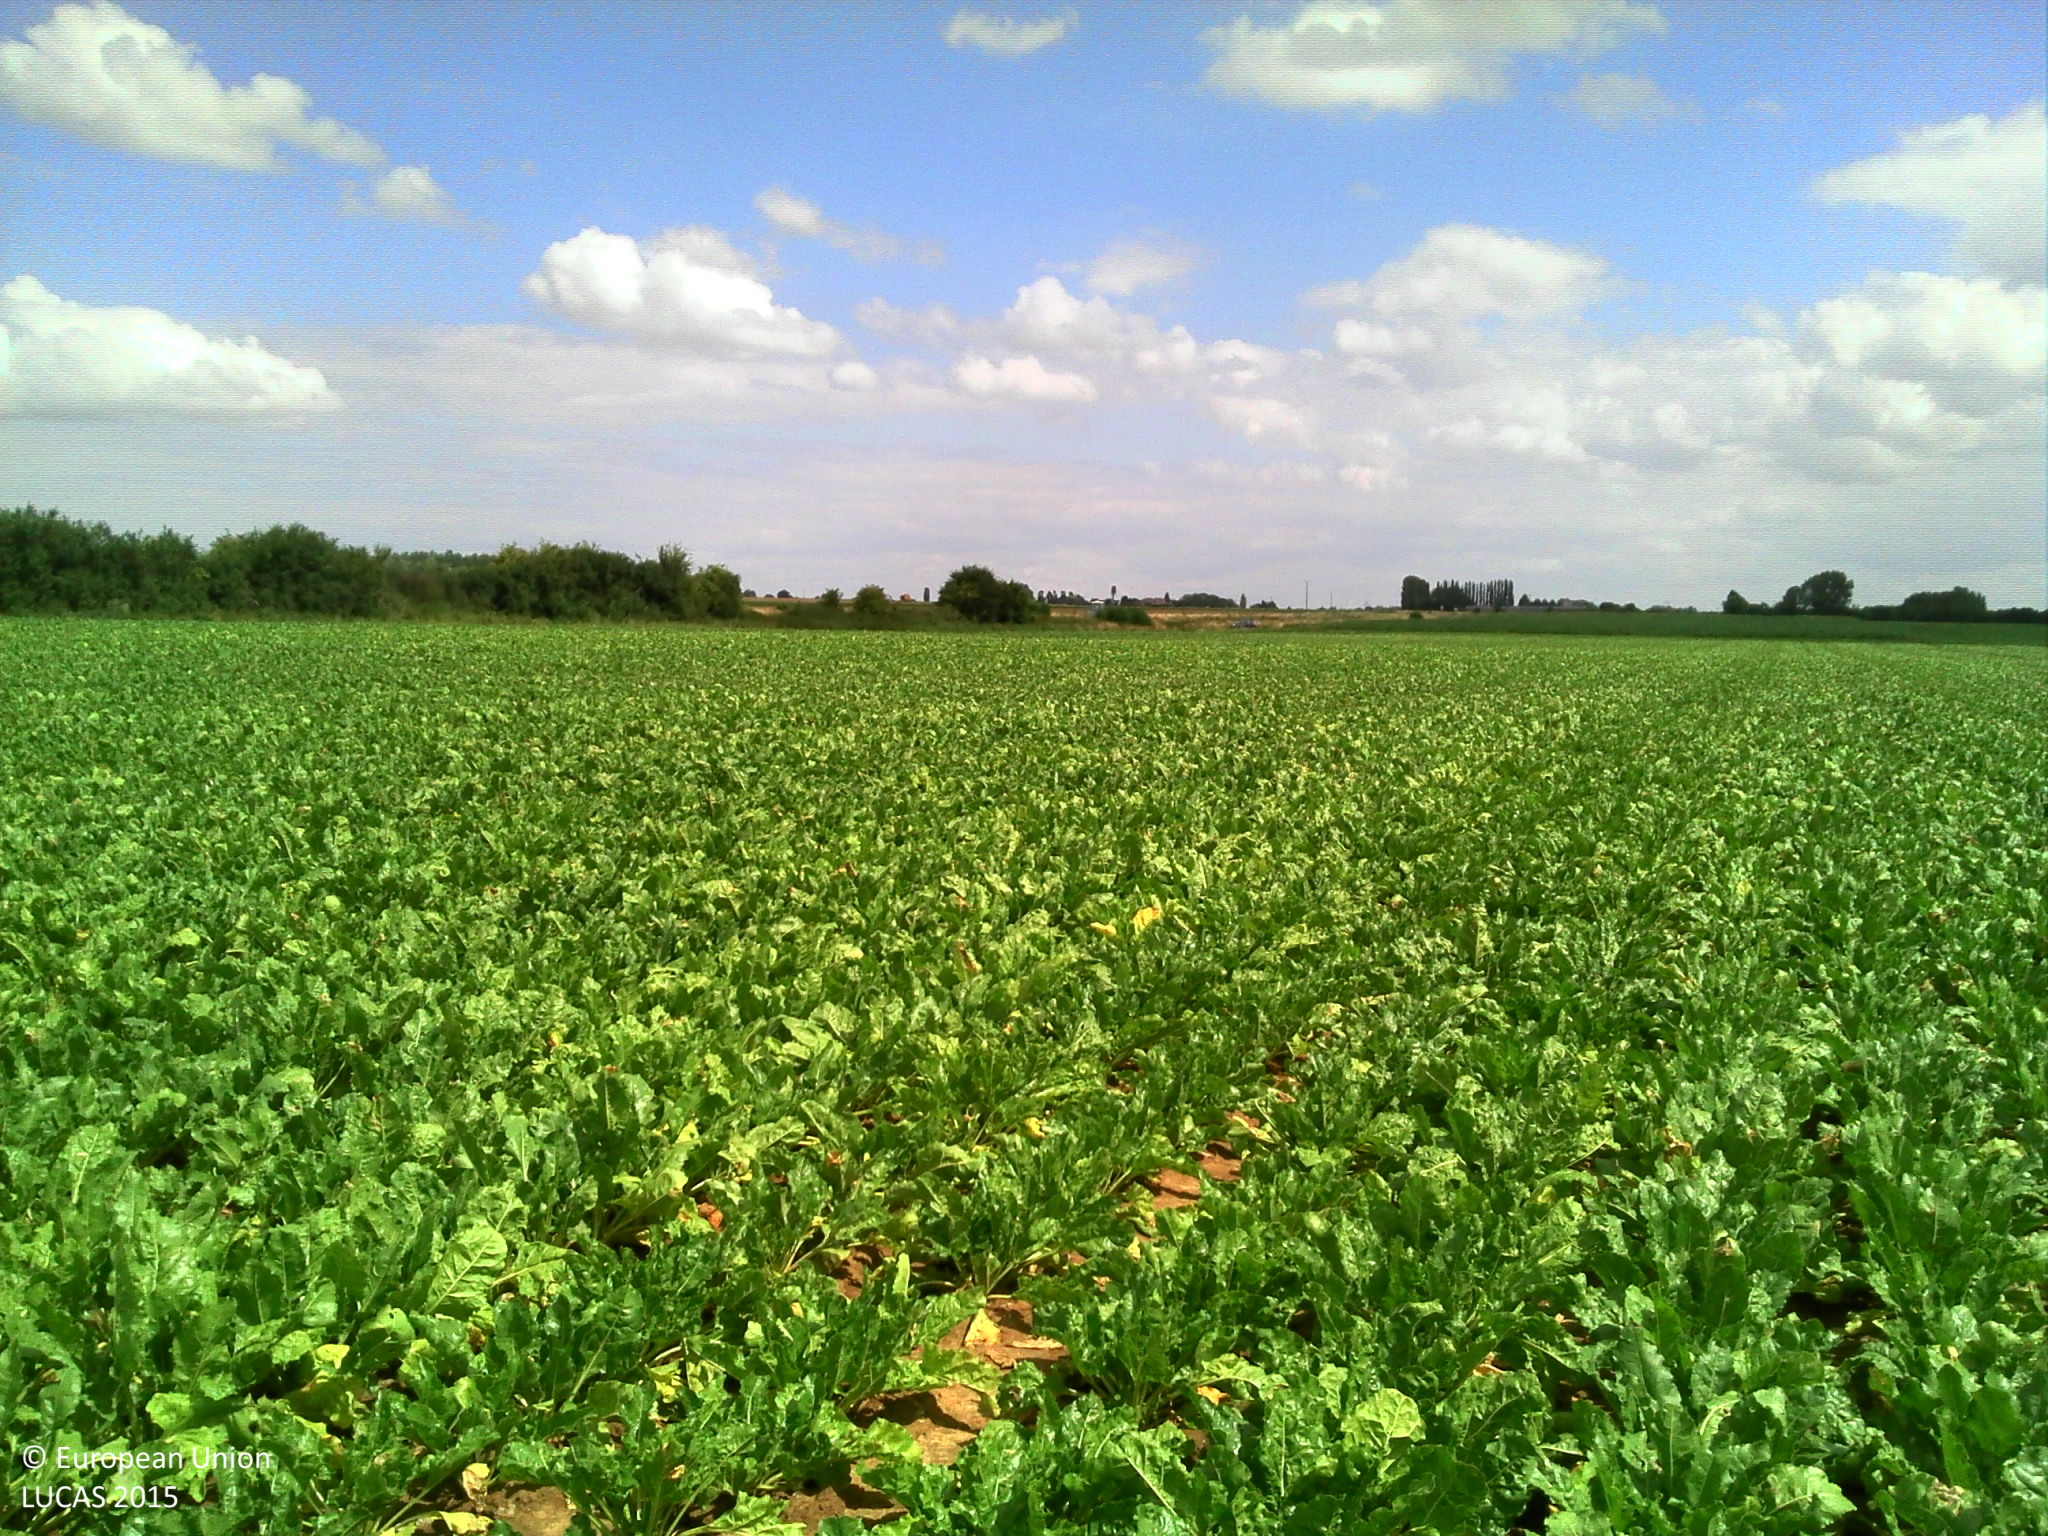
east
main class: Cropland
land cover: Sugar beet
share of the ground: > 75 %
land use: Agriculture (excluding fallow land and kitchen gardens)
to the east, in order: Sugar beet
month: August
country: FR
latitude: 49.8106
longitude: 2.7770
